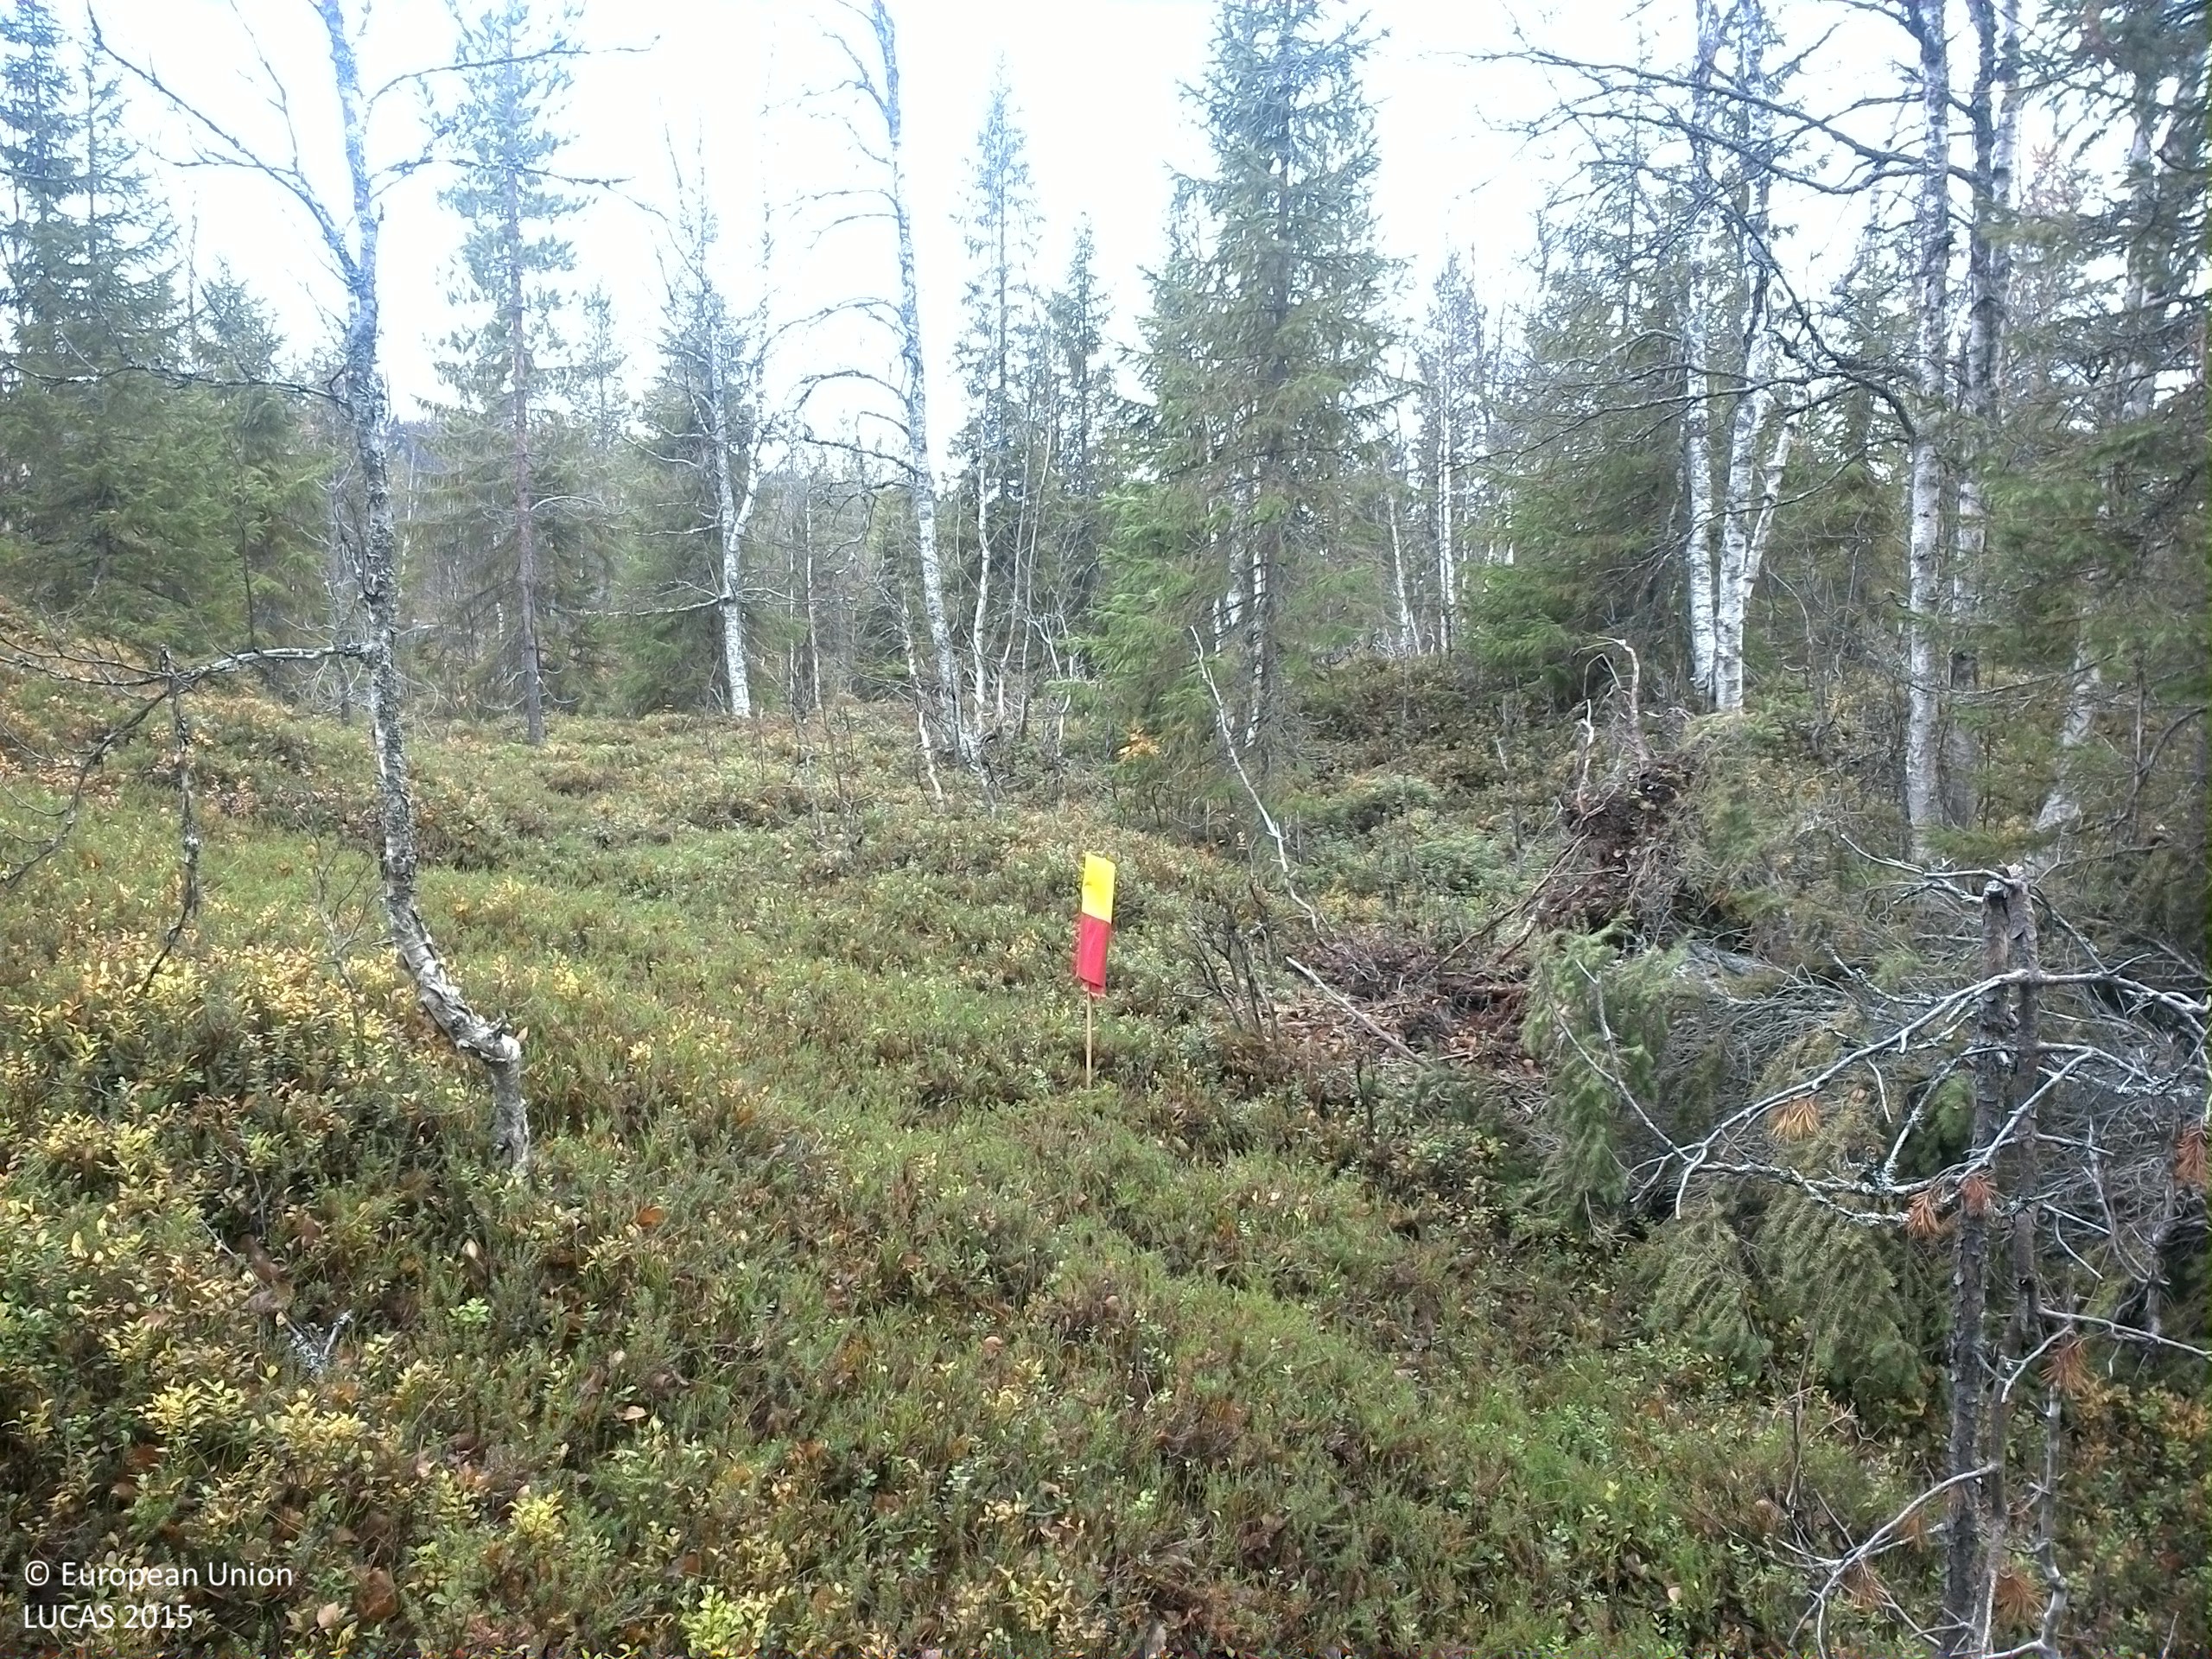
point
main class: Woodland
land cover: Spruce dominated mixed woodland
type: boreal forest
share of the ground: 25 - 50 %
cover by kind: shrubs 50 %, coniferous forest trees 20 %, broadleaved forest trees 20 %, lichens and mosses 10 %
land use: Forestry
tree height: > 5 m
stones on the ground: 25 - 50 %
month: October
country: SE
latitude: 64.4169
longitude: 14.7675
